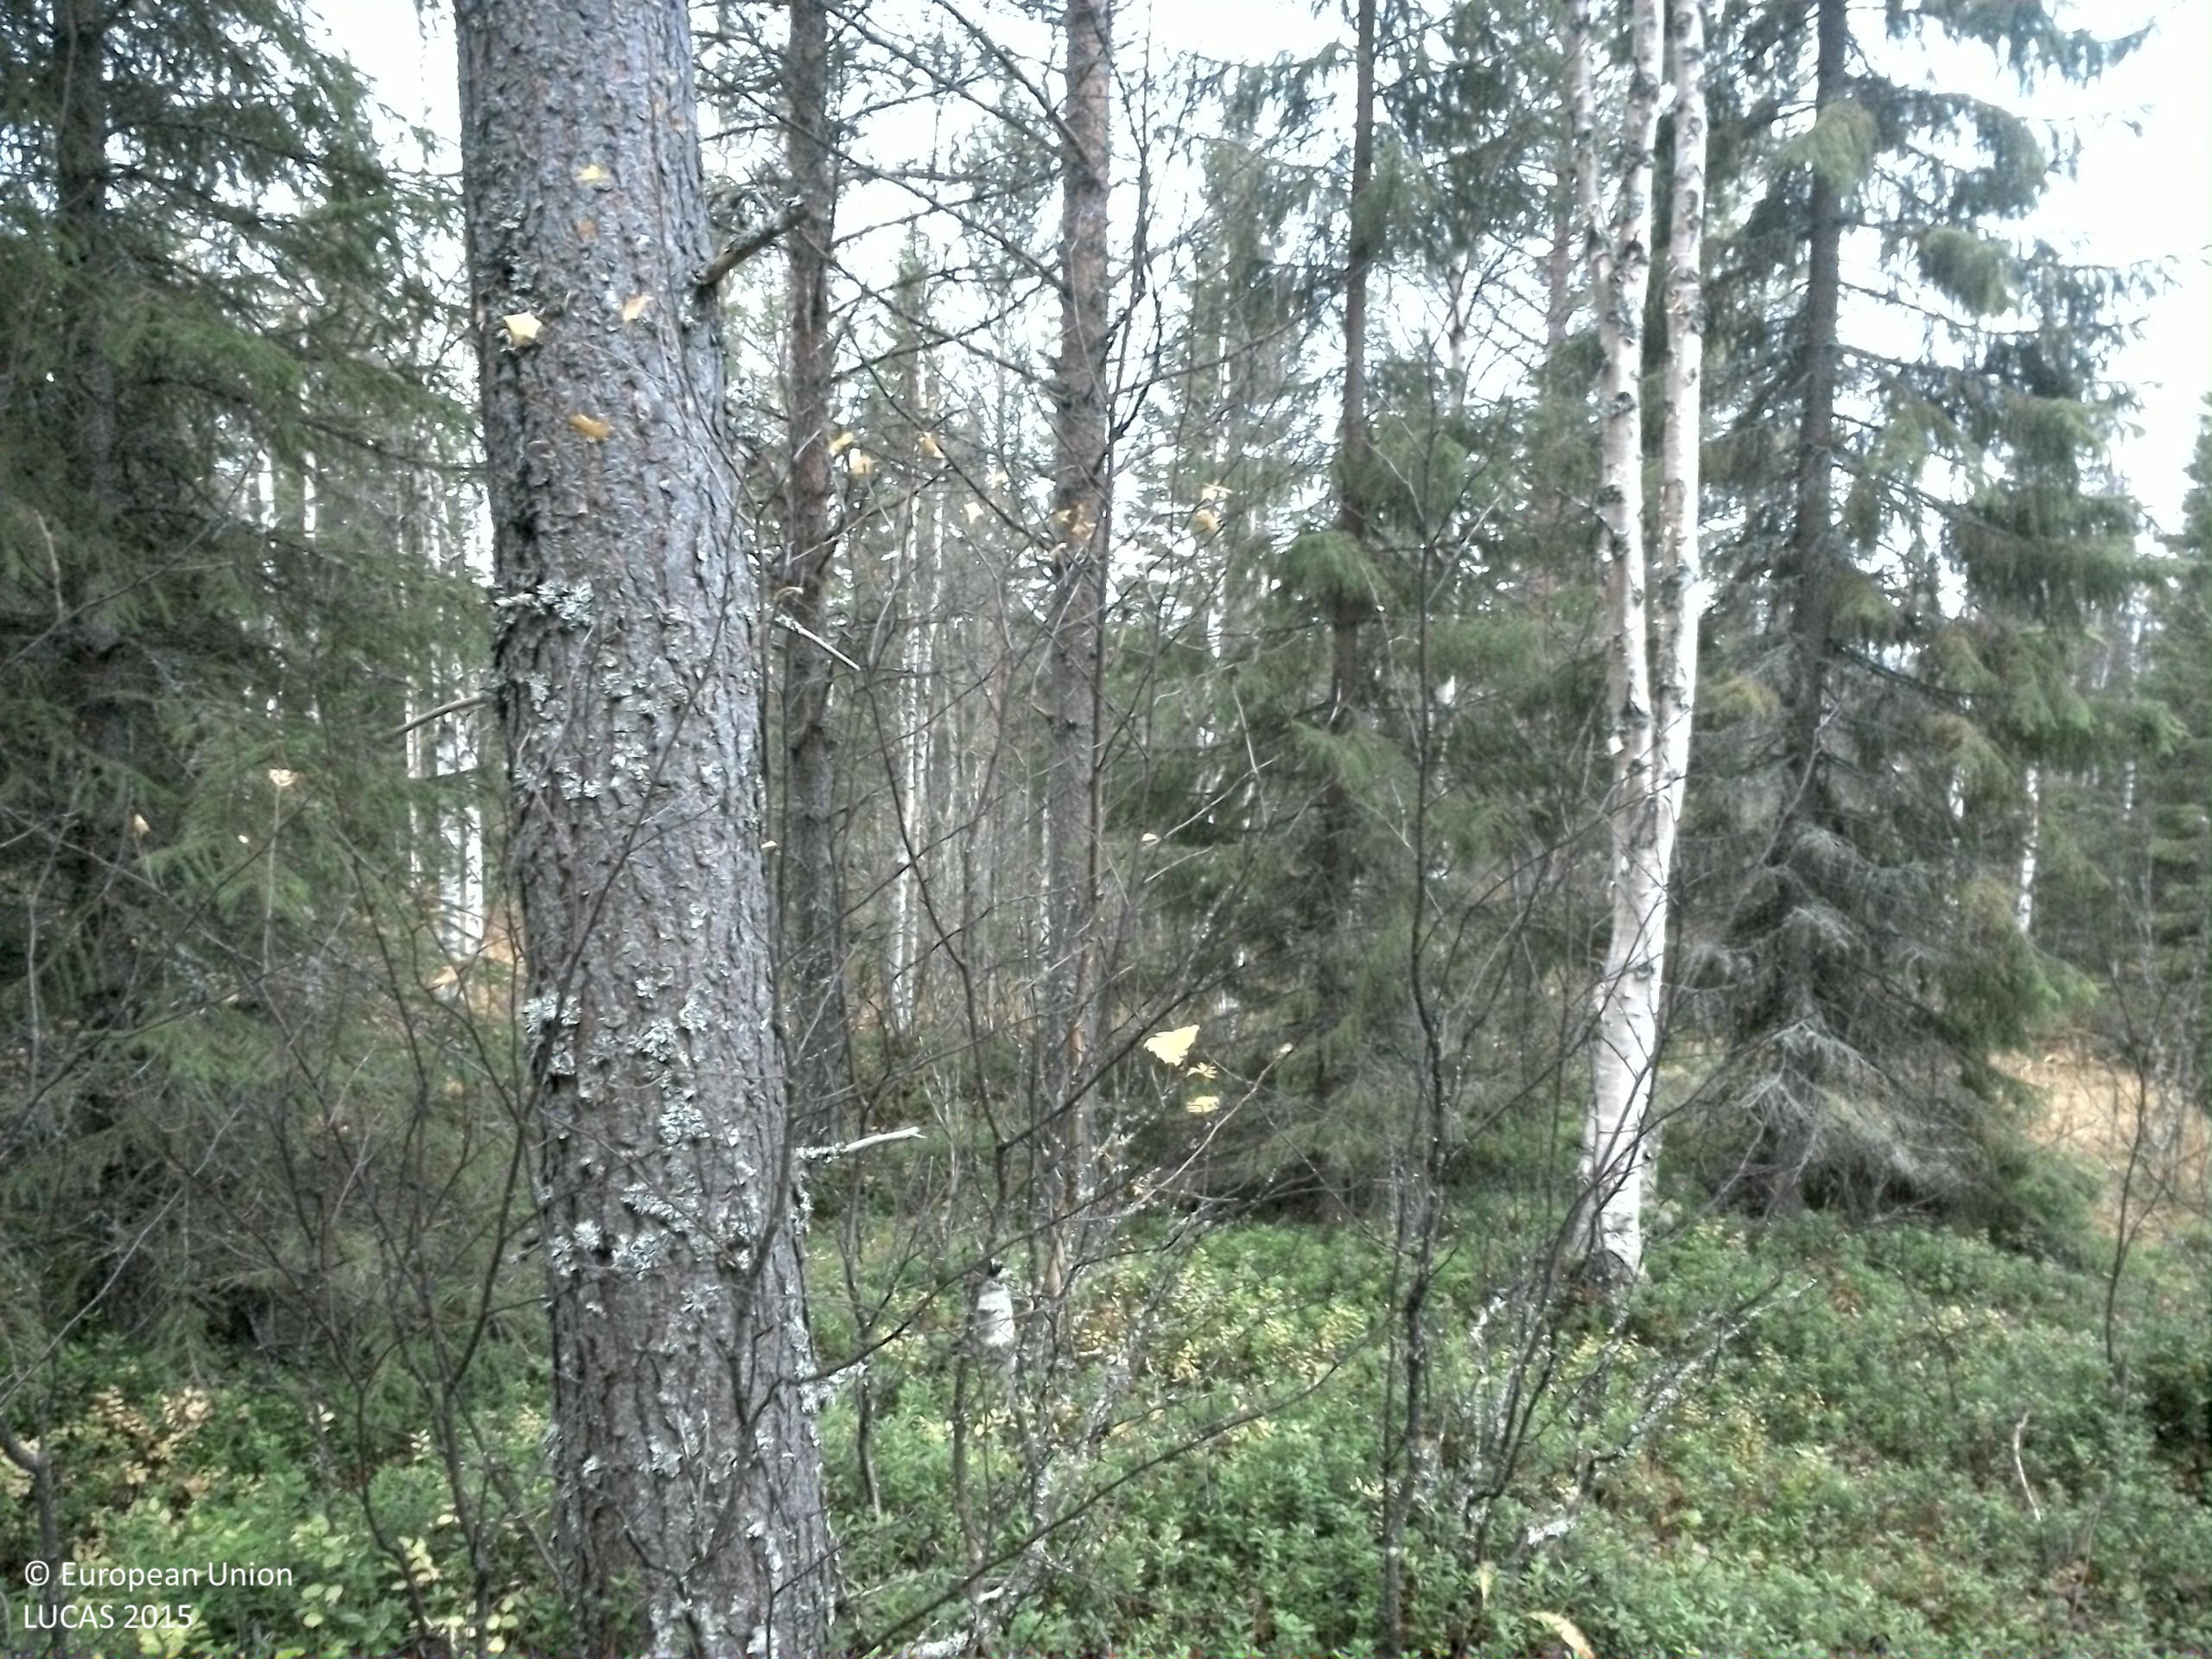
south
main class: Woodland
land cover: Other mixed woodland
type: boreal forest
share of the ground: 50 - 75 %
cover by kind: coniferous forest trees 45 %, shrubs 30 %, broadleaved forest trees 15 %, lichens and mosses 10 %
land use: Forestry
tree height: > 5 m
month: October
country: SE
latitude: 64.3101
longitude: 15.2852
